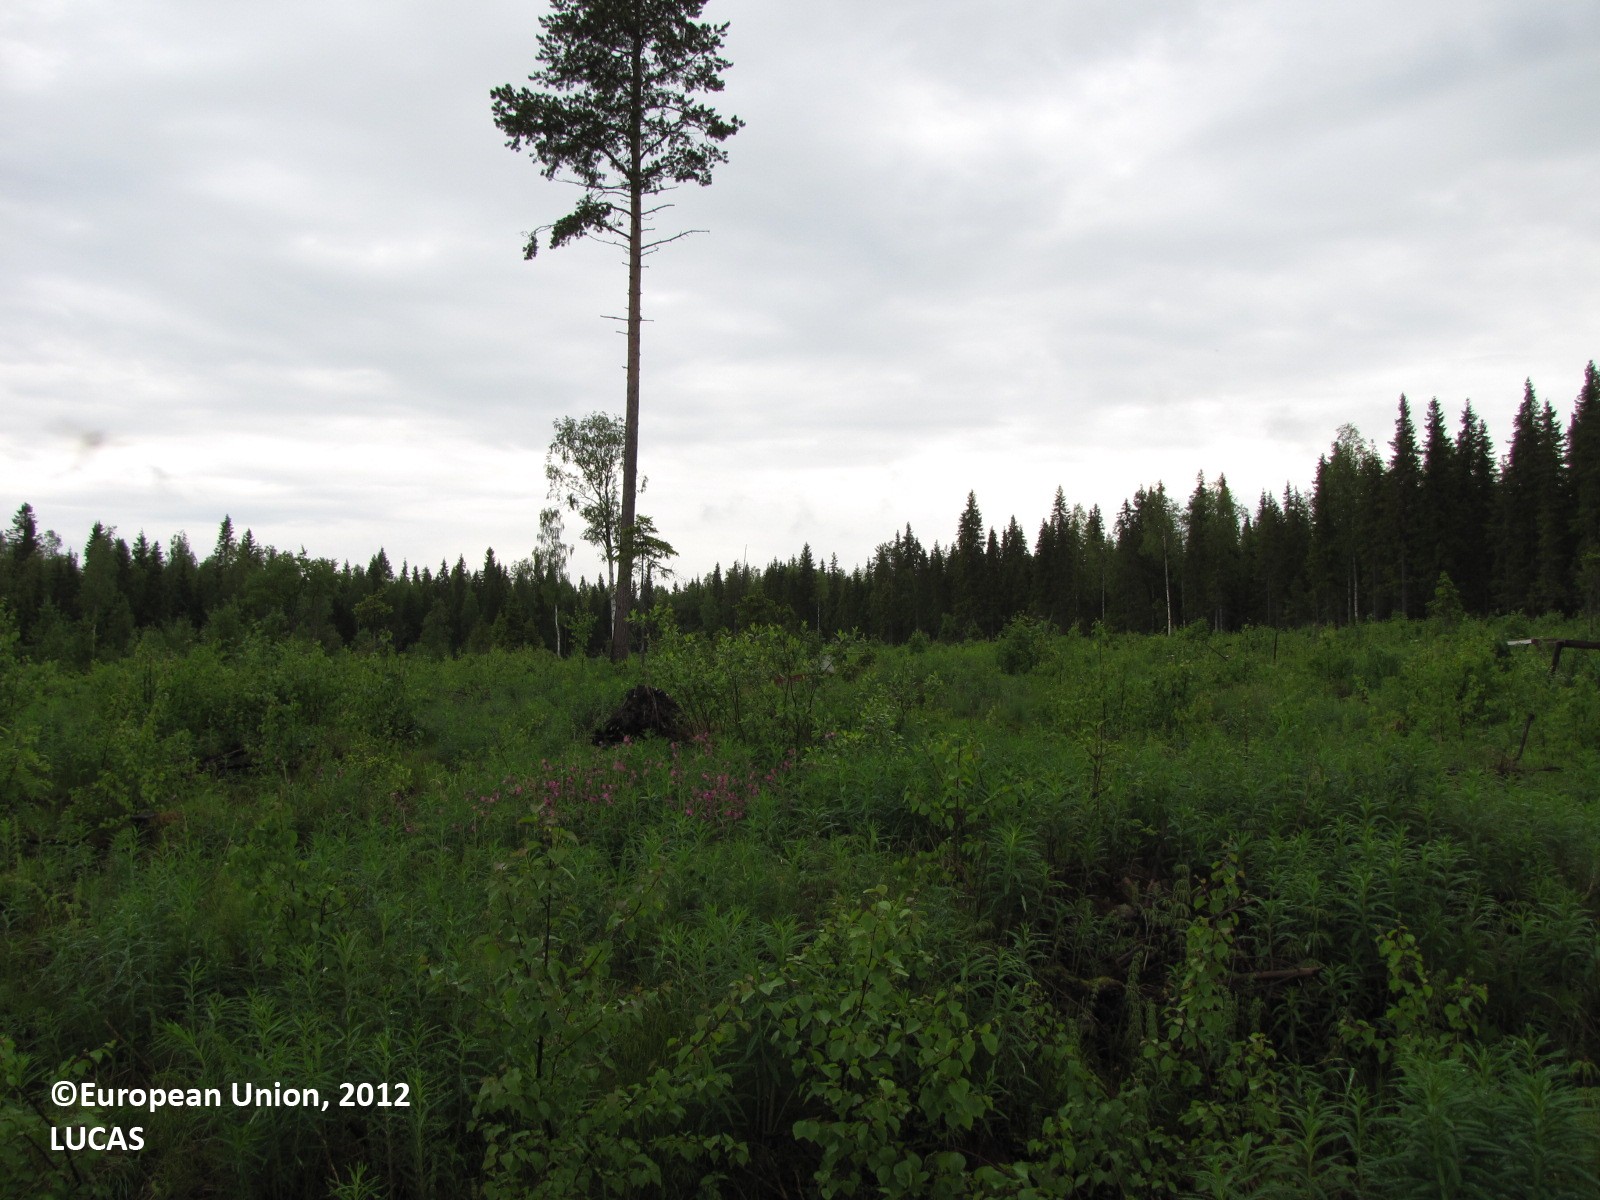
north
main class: Grassland
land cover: Grassland with sparse tree/shrub cover
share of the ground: > 75 %
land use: Forestry
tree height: < 5 m
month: June
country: FI
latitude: 65.9955
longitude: 24.3008
